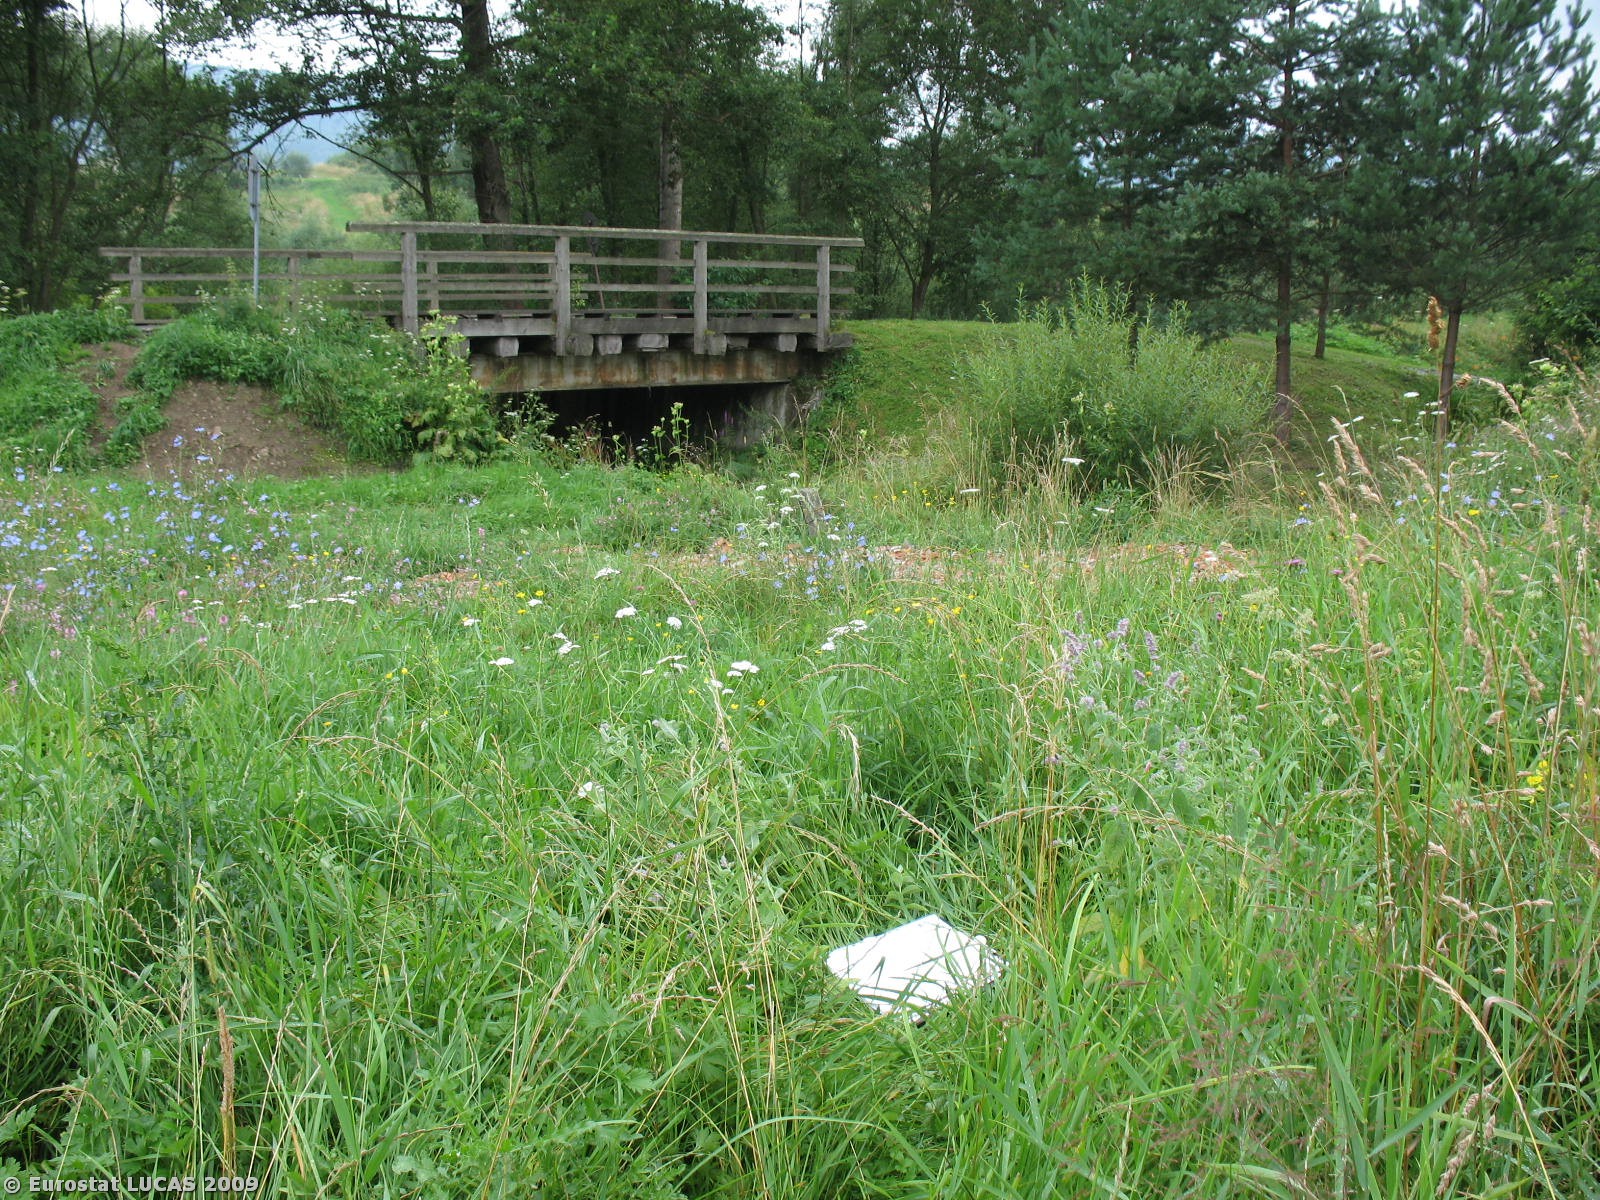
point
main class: Grassland
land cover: Spontaneously vegetated surfaces
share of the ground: > 75 %
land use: Unused
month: May
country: PL
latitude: 49.4658
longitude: 22.5807
